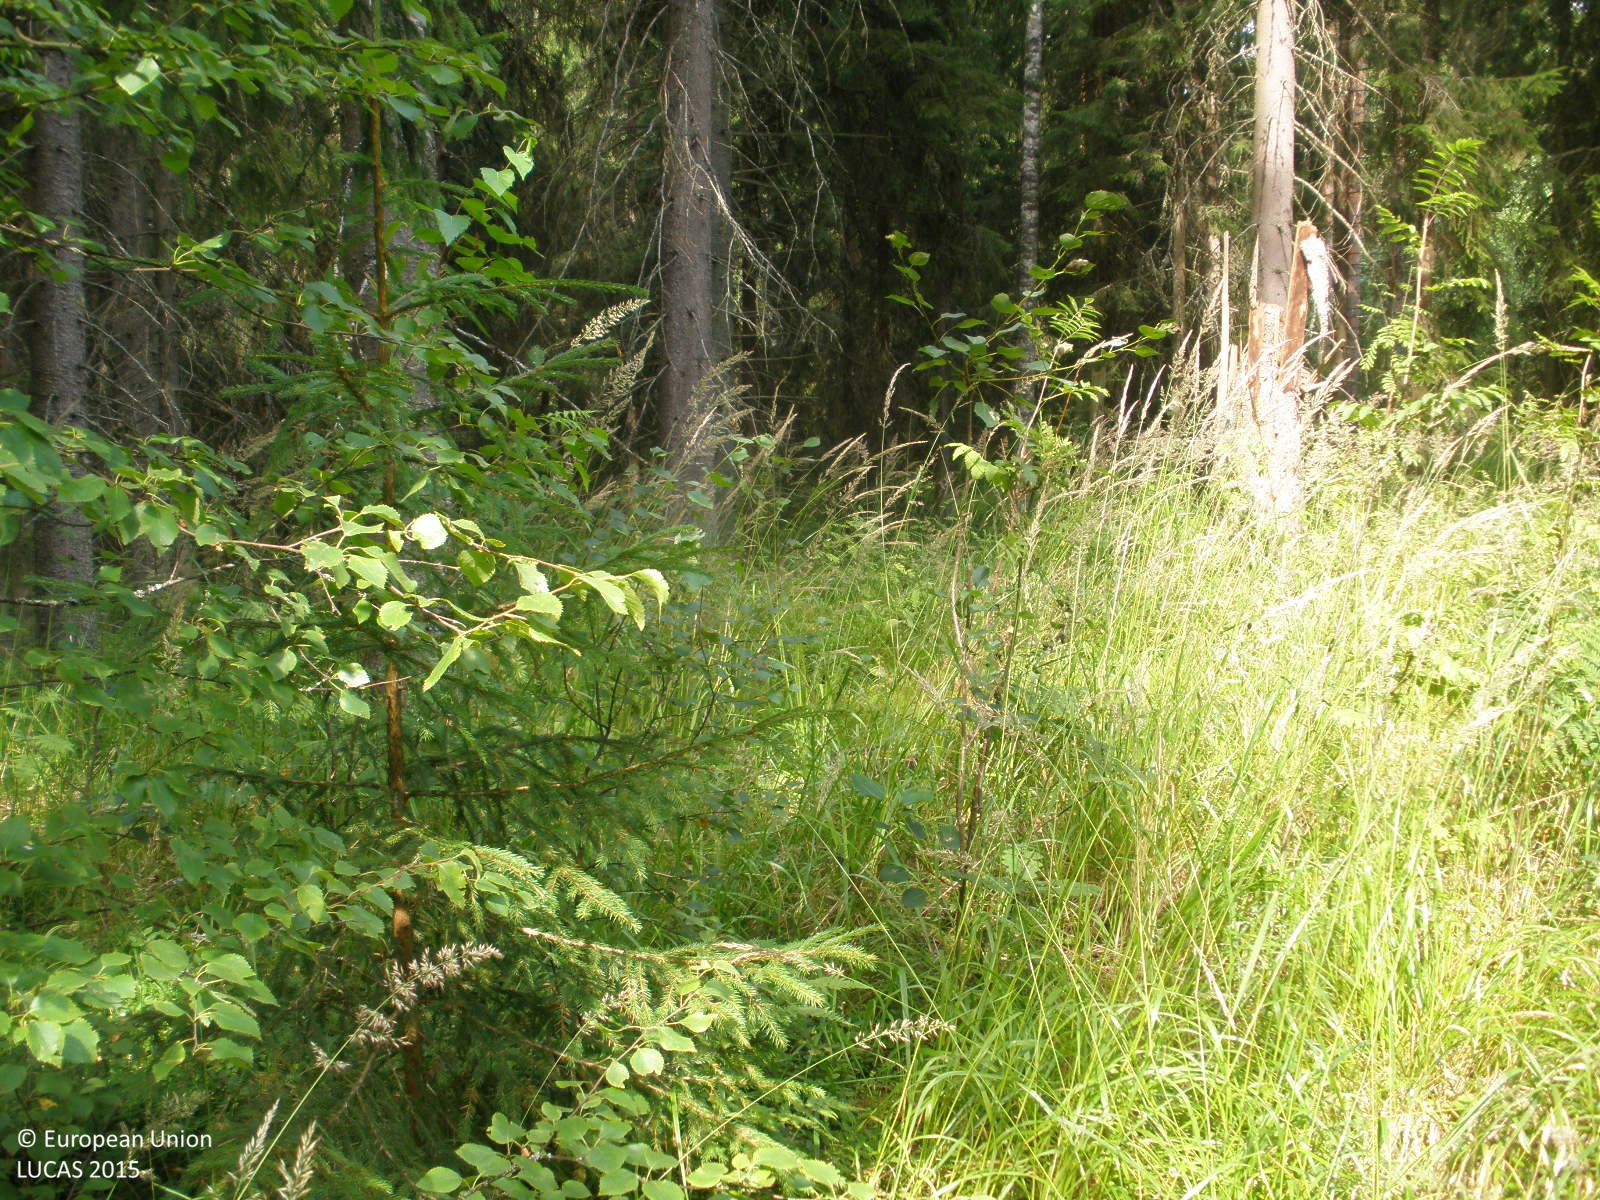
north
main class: Woodland
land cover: Other coniferous woodland
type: boreal forest
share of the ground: > 75 %
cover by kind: coniferous forest trees 85 %, herbaceous plants 10 %, lichens and mosses 5 %
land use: Forestry
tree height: > 5 m
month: August
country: FI
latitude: 60.8244
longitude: 24.4653
